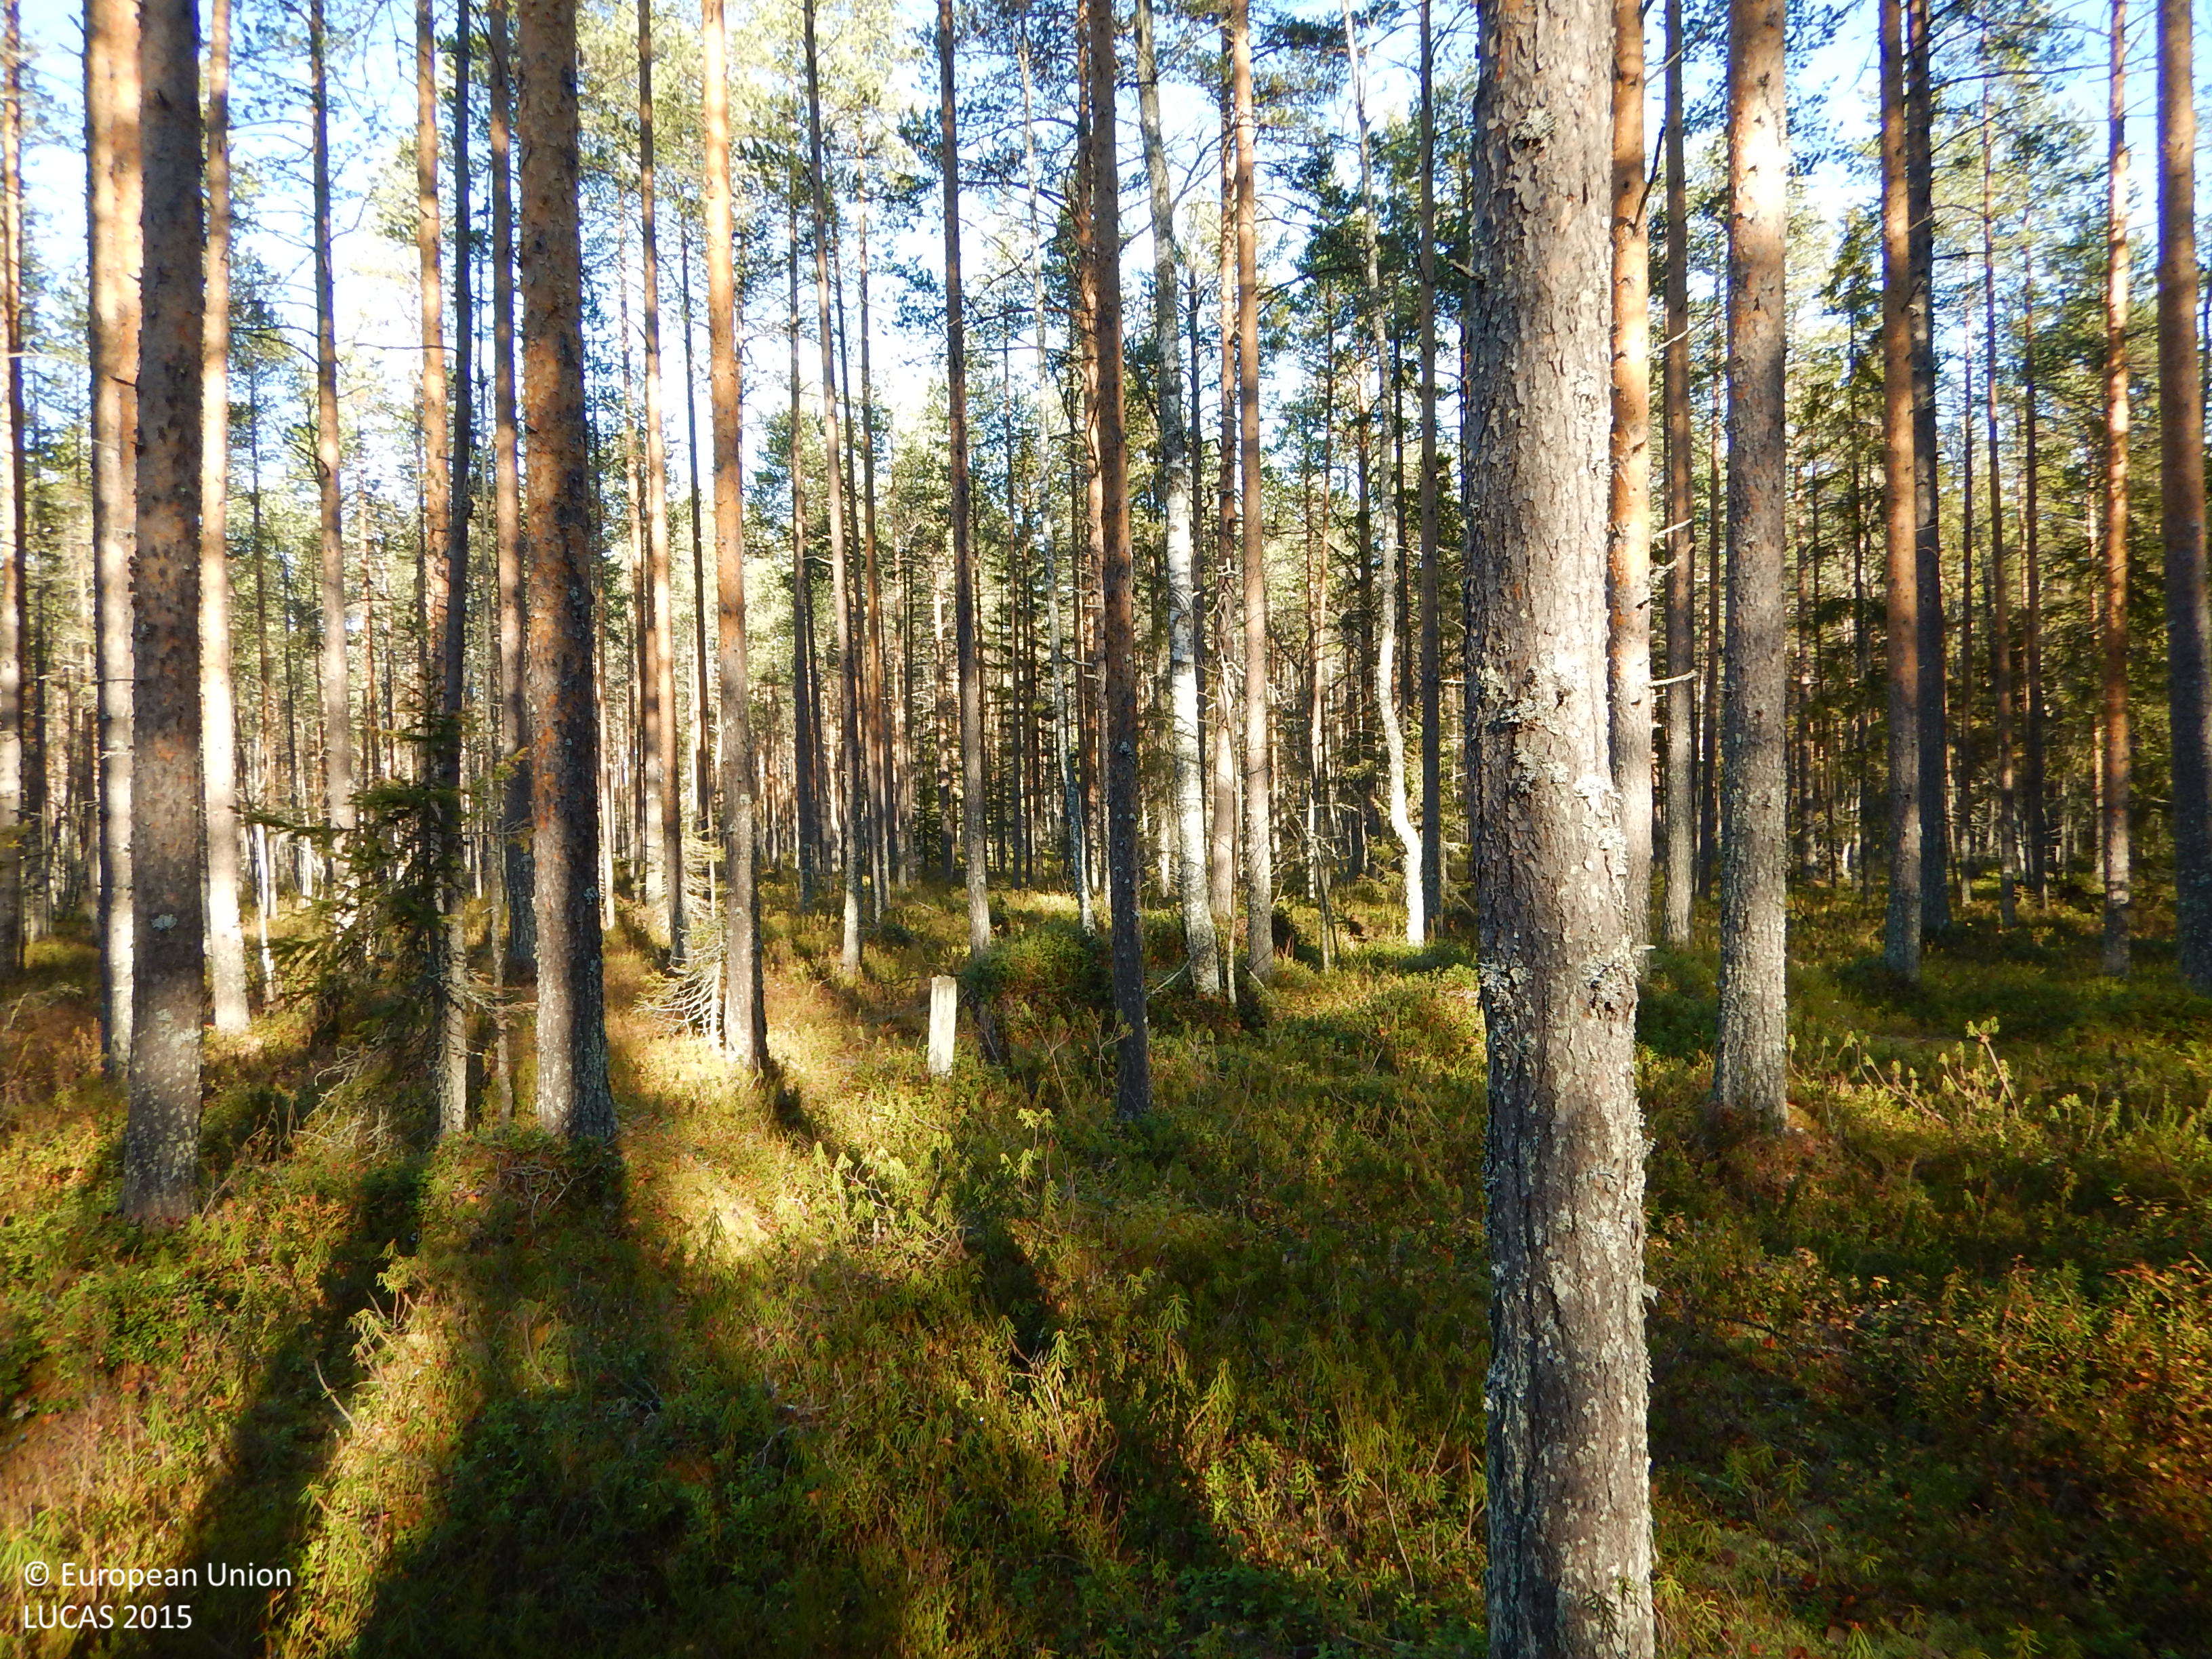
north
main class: Woodland
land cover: Pine dominated coniferous woodland
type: boreal forest
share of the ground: 50 - 75 %
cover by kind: coniferous forest trees 60 %, shrubs 15 %, lichens and mosses 15 %, broadleaved forest trees 5 %, herbaceous plants 5 %
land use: Forestry
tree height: > 5 m
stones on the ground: < 10 %
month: October
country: SE
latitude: 65.0476
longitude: 21.1296
